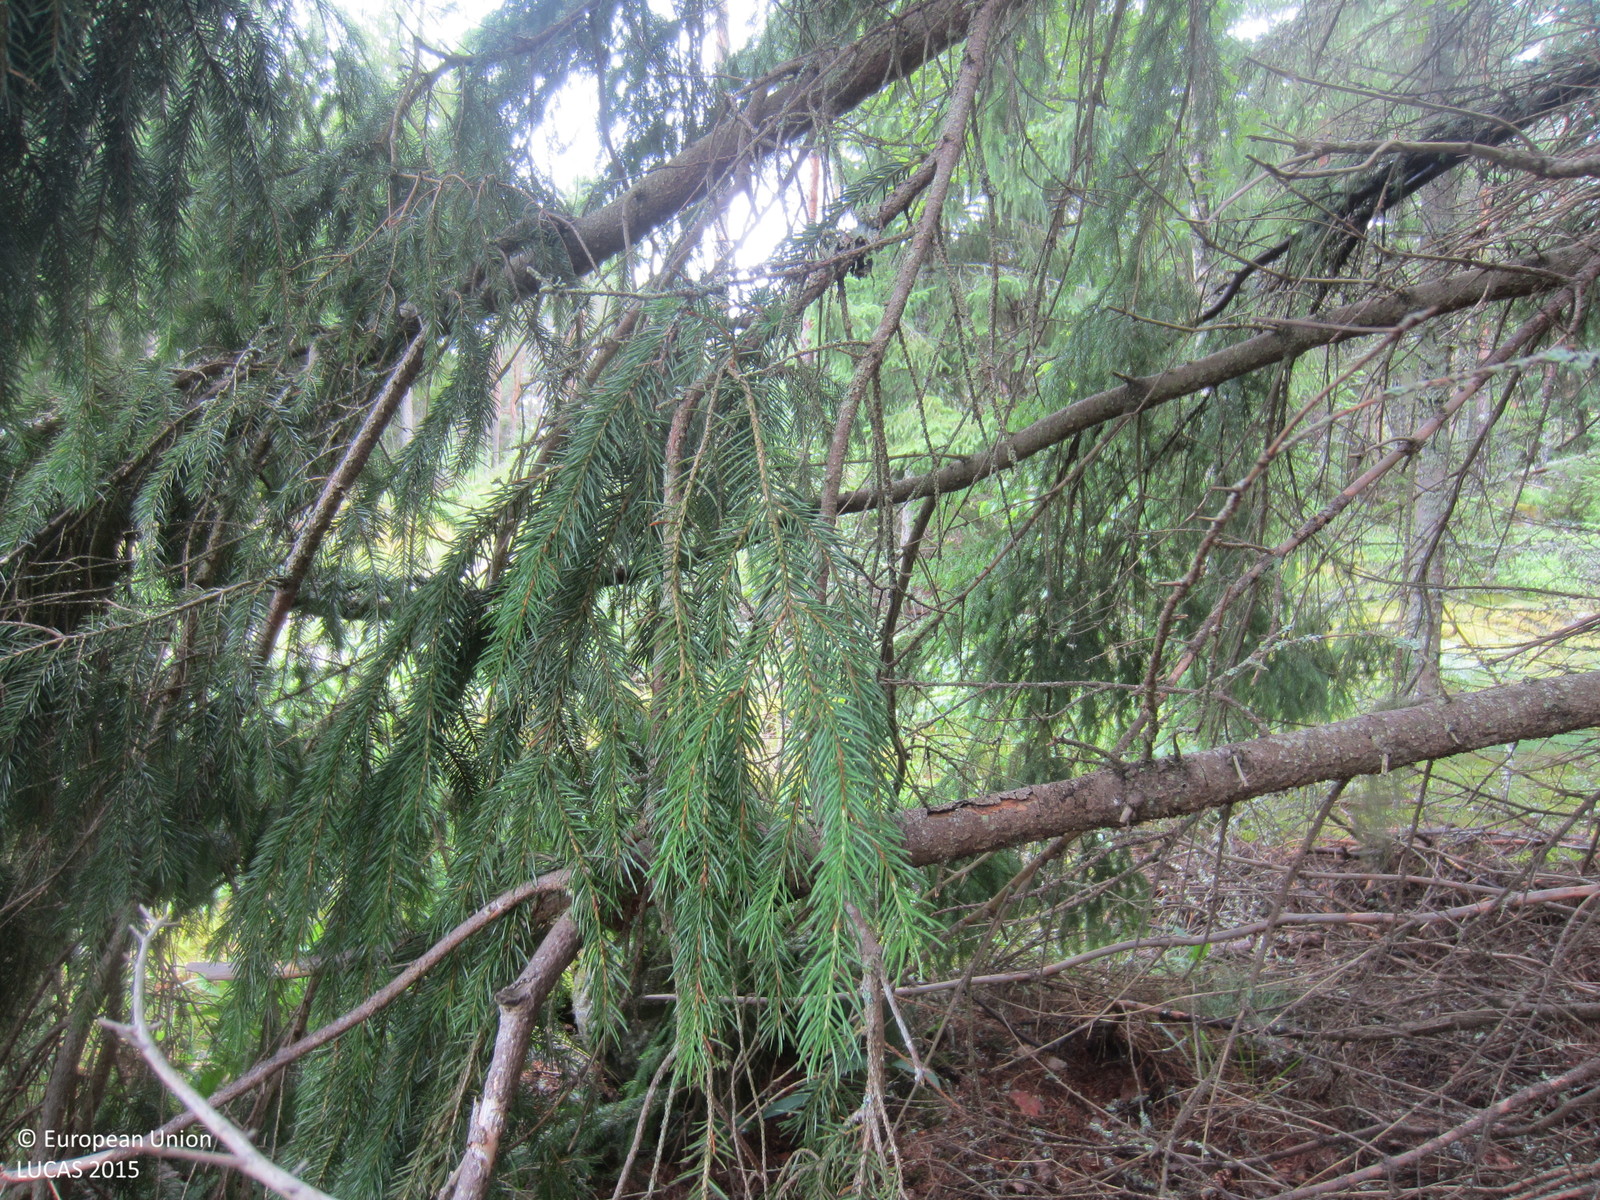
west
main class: Woodland
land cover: Spruce dominated coniferous woodland
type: boreal forest
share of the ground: 50 - 75 %
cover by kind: coniferous forest trees 70 %, lichens and mosses 25 %, broadleaved forest trees 5 %
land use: Forestry
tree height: > 5 m
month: July
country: SE
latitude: 59.8456
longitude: 16.9705
